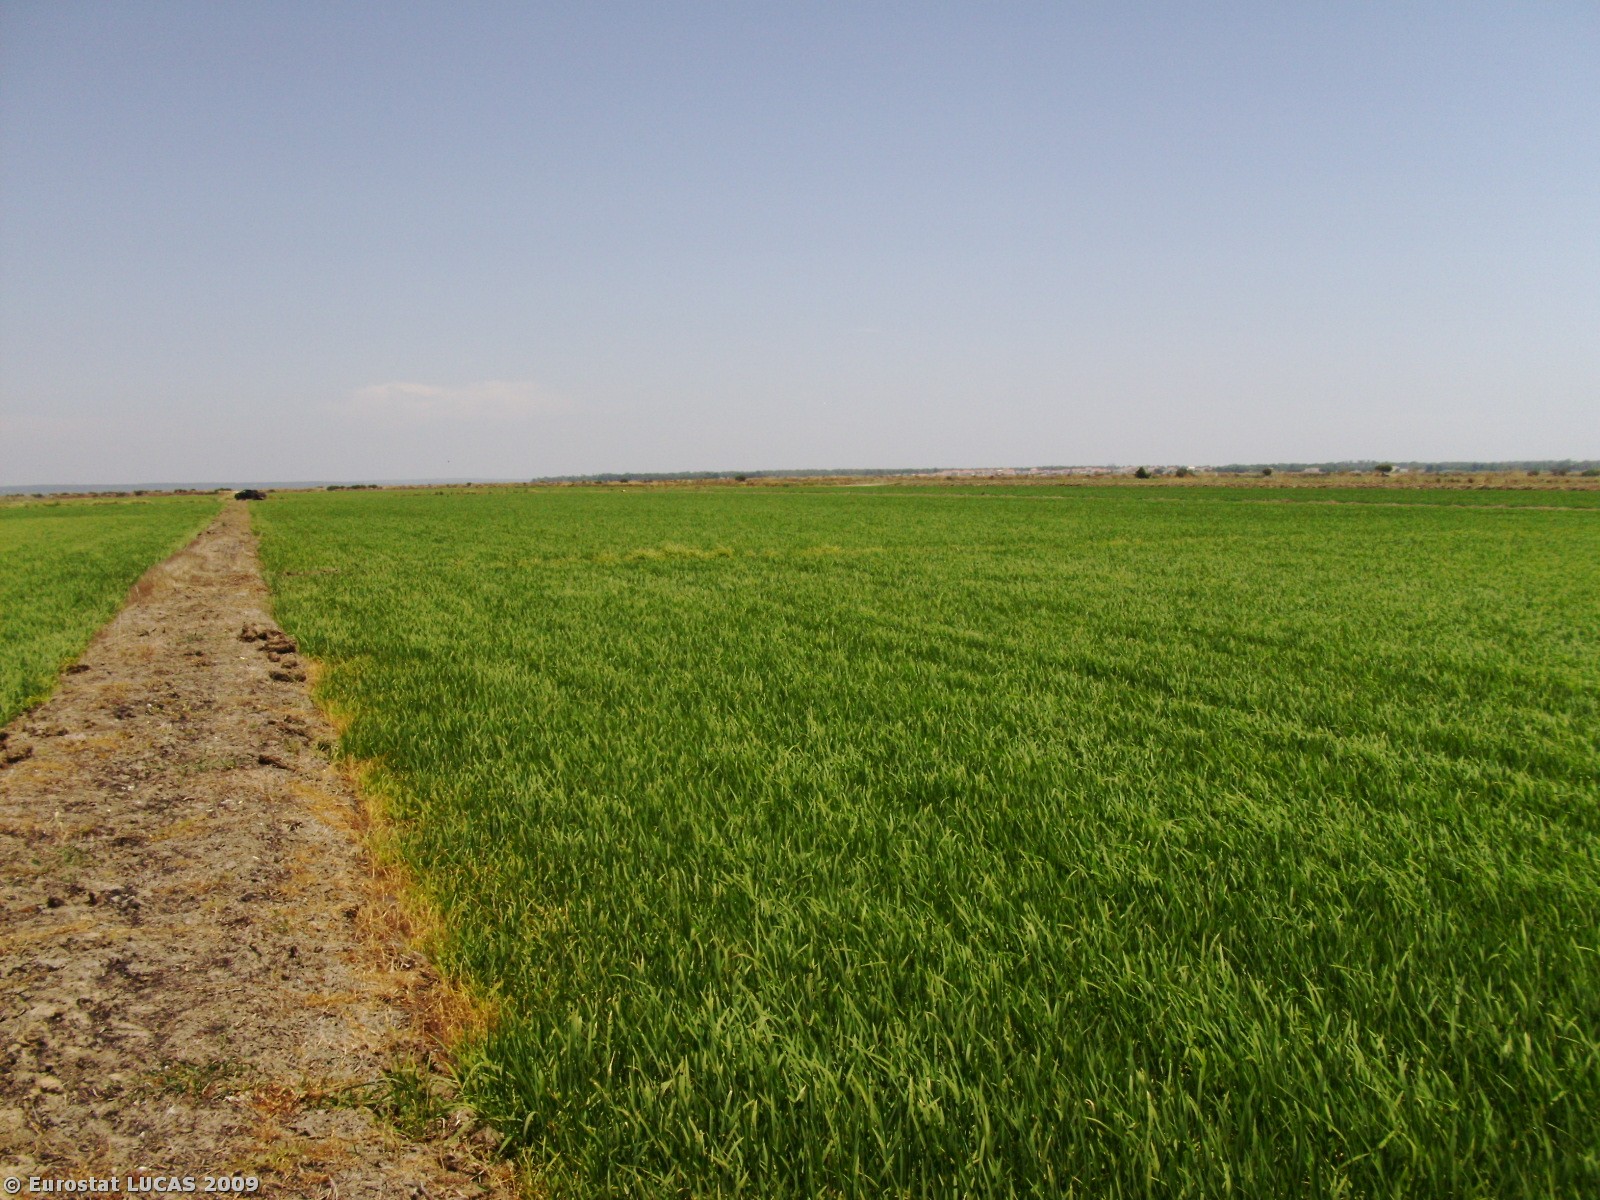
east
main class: Cropland
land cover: Rice
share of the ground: > 75 %
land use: Agriculture (excluding fallow land and kitchen gardens)
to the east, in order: Rice; Other structural elements; Rice; Rivers and streams; Rice
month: June
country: PT
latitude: 38.4158
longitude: -8.7847
